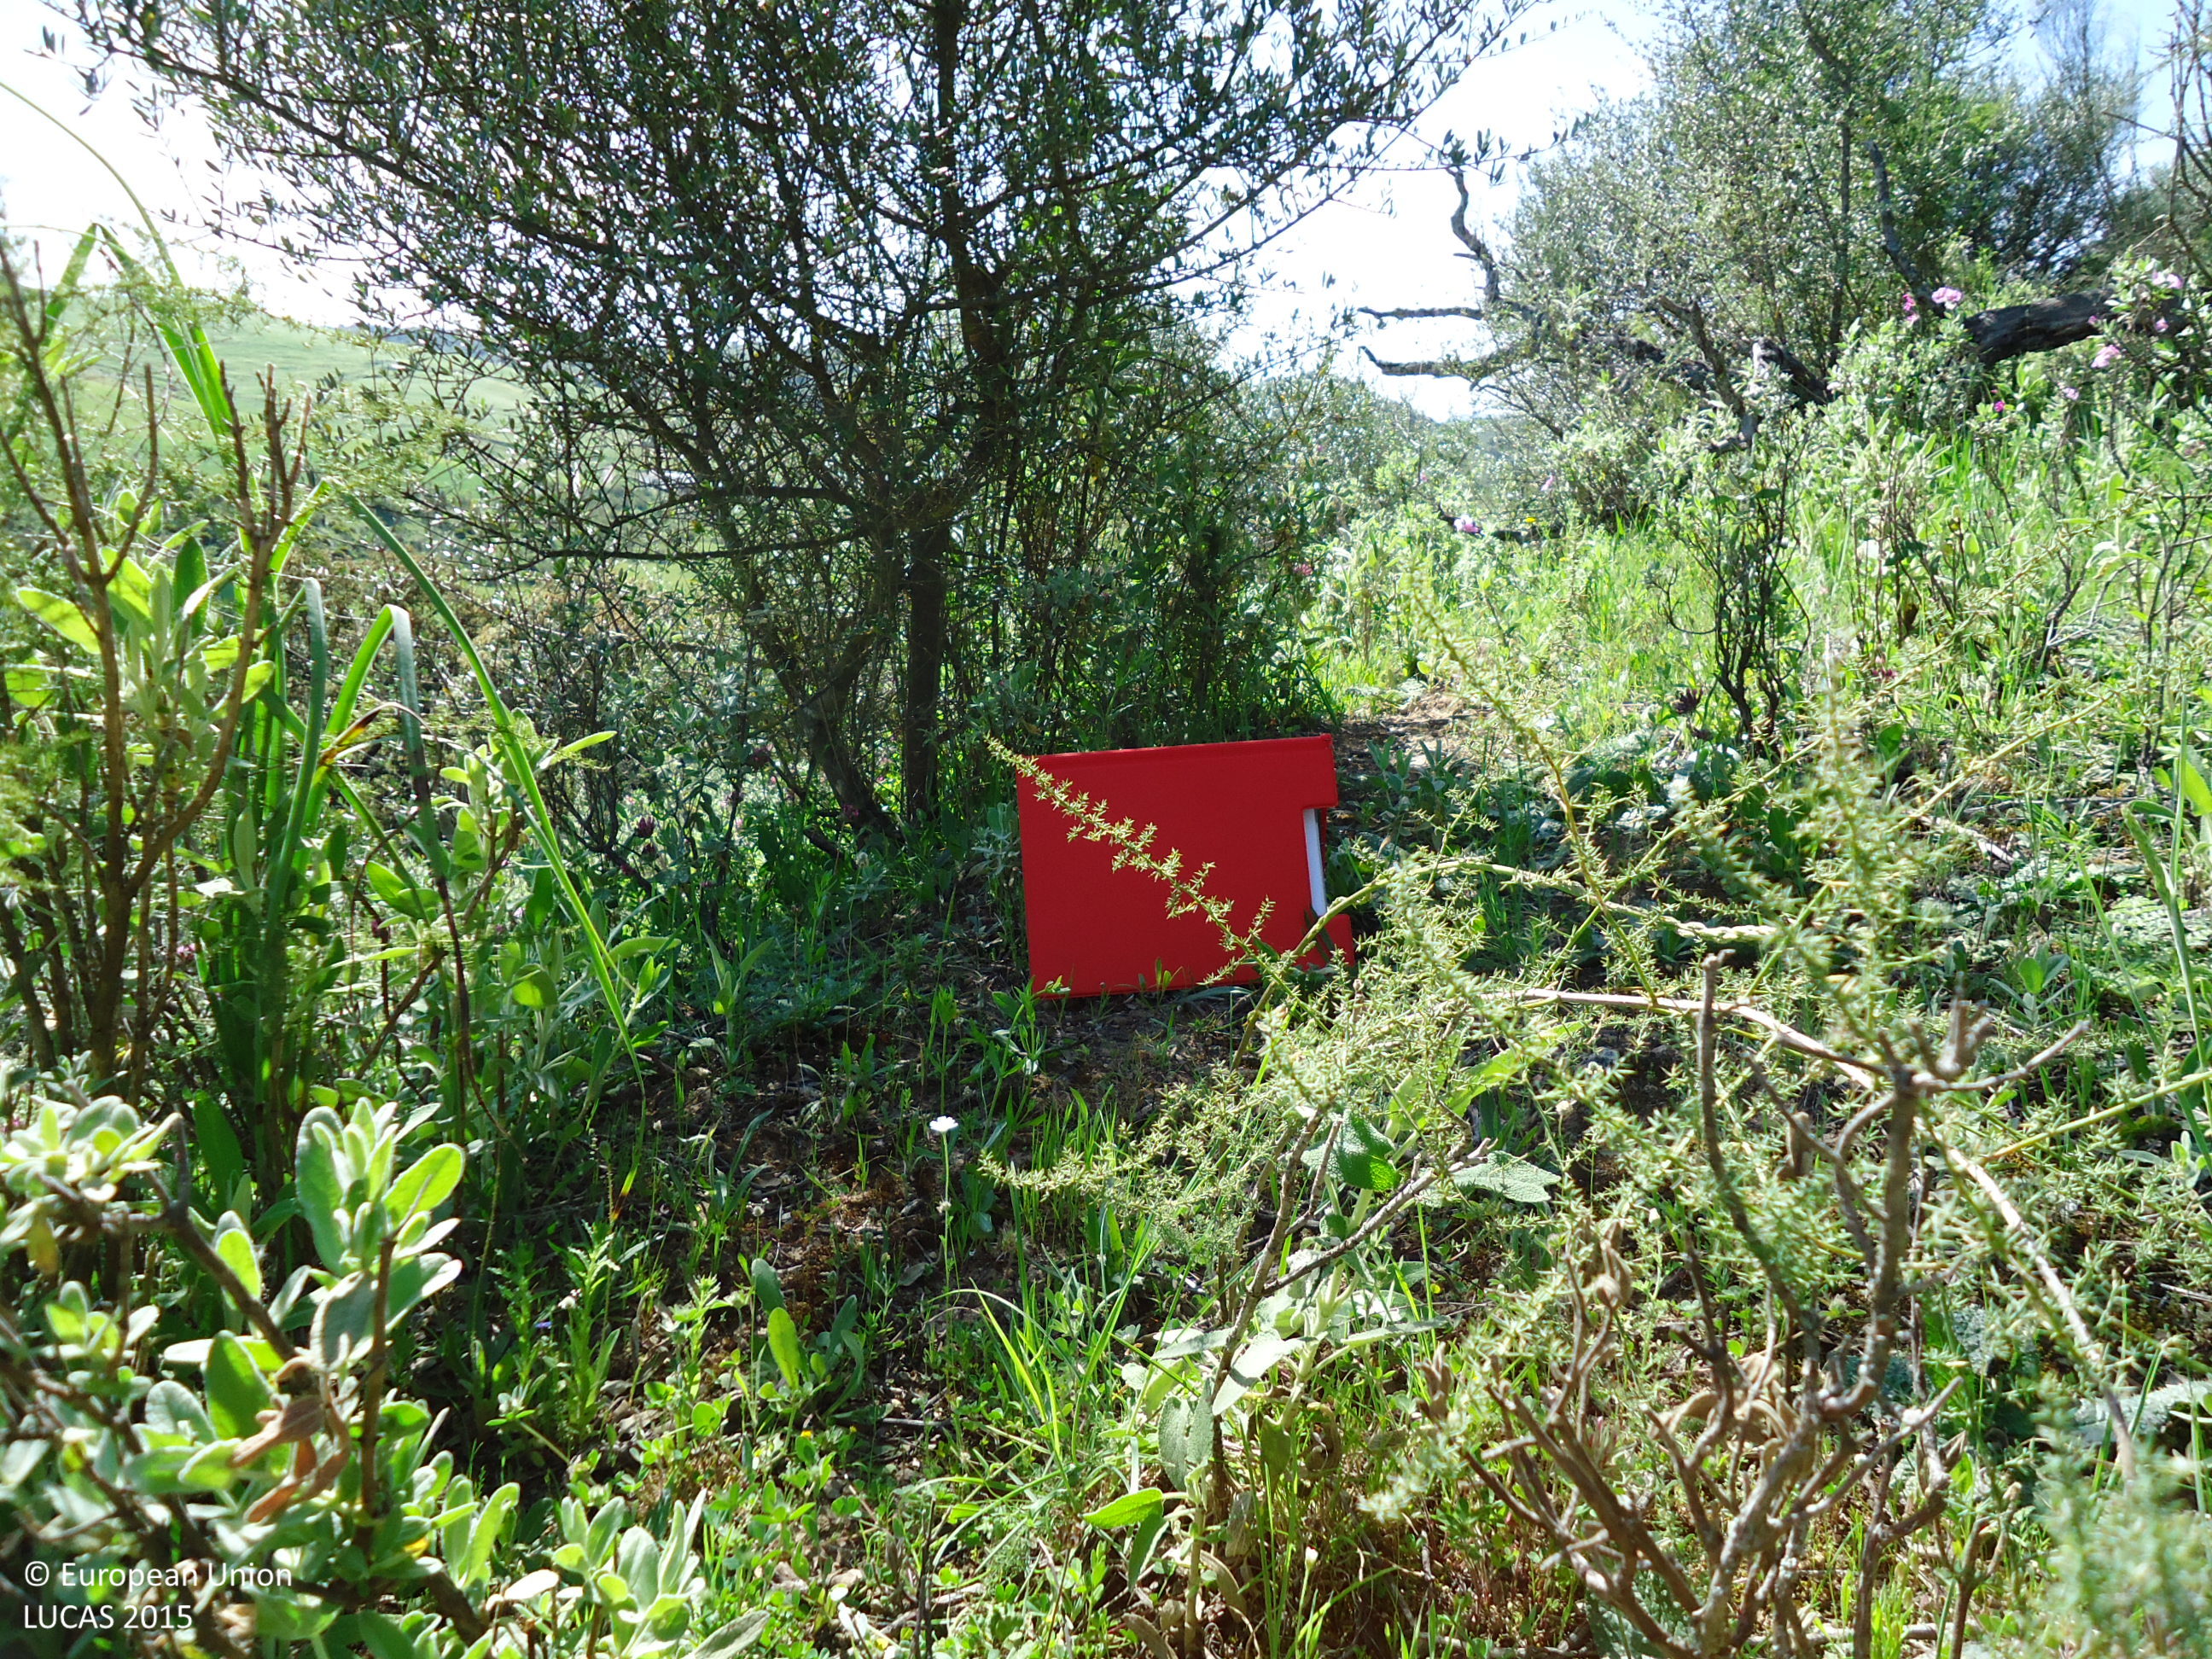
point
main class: Shrubland
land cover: Shrubland with sparse tree cover
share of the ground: 50 - 75 %
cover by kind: shrubs 70 %, herbaceous plants 25 %, broadleaved forest trees 5 %
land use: Agriculture (excluding fallow land and kitchen gardens)
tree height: > 5 m
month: April
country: ES
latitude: 36.9348
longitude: -5.3533
